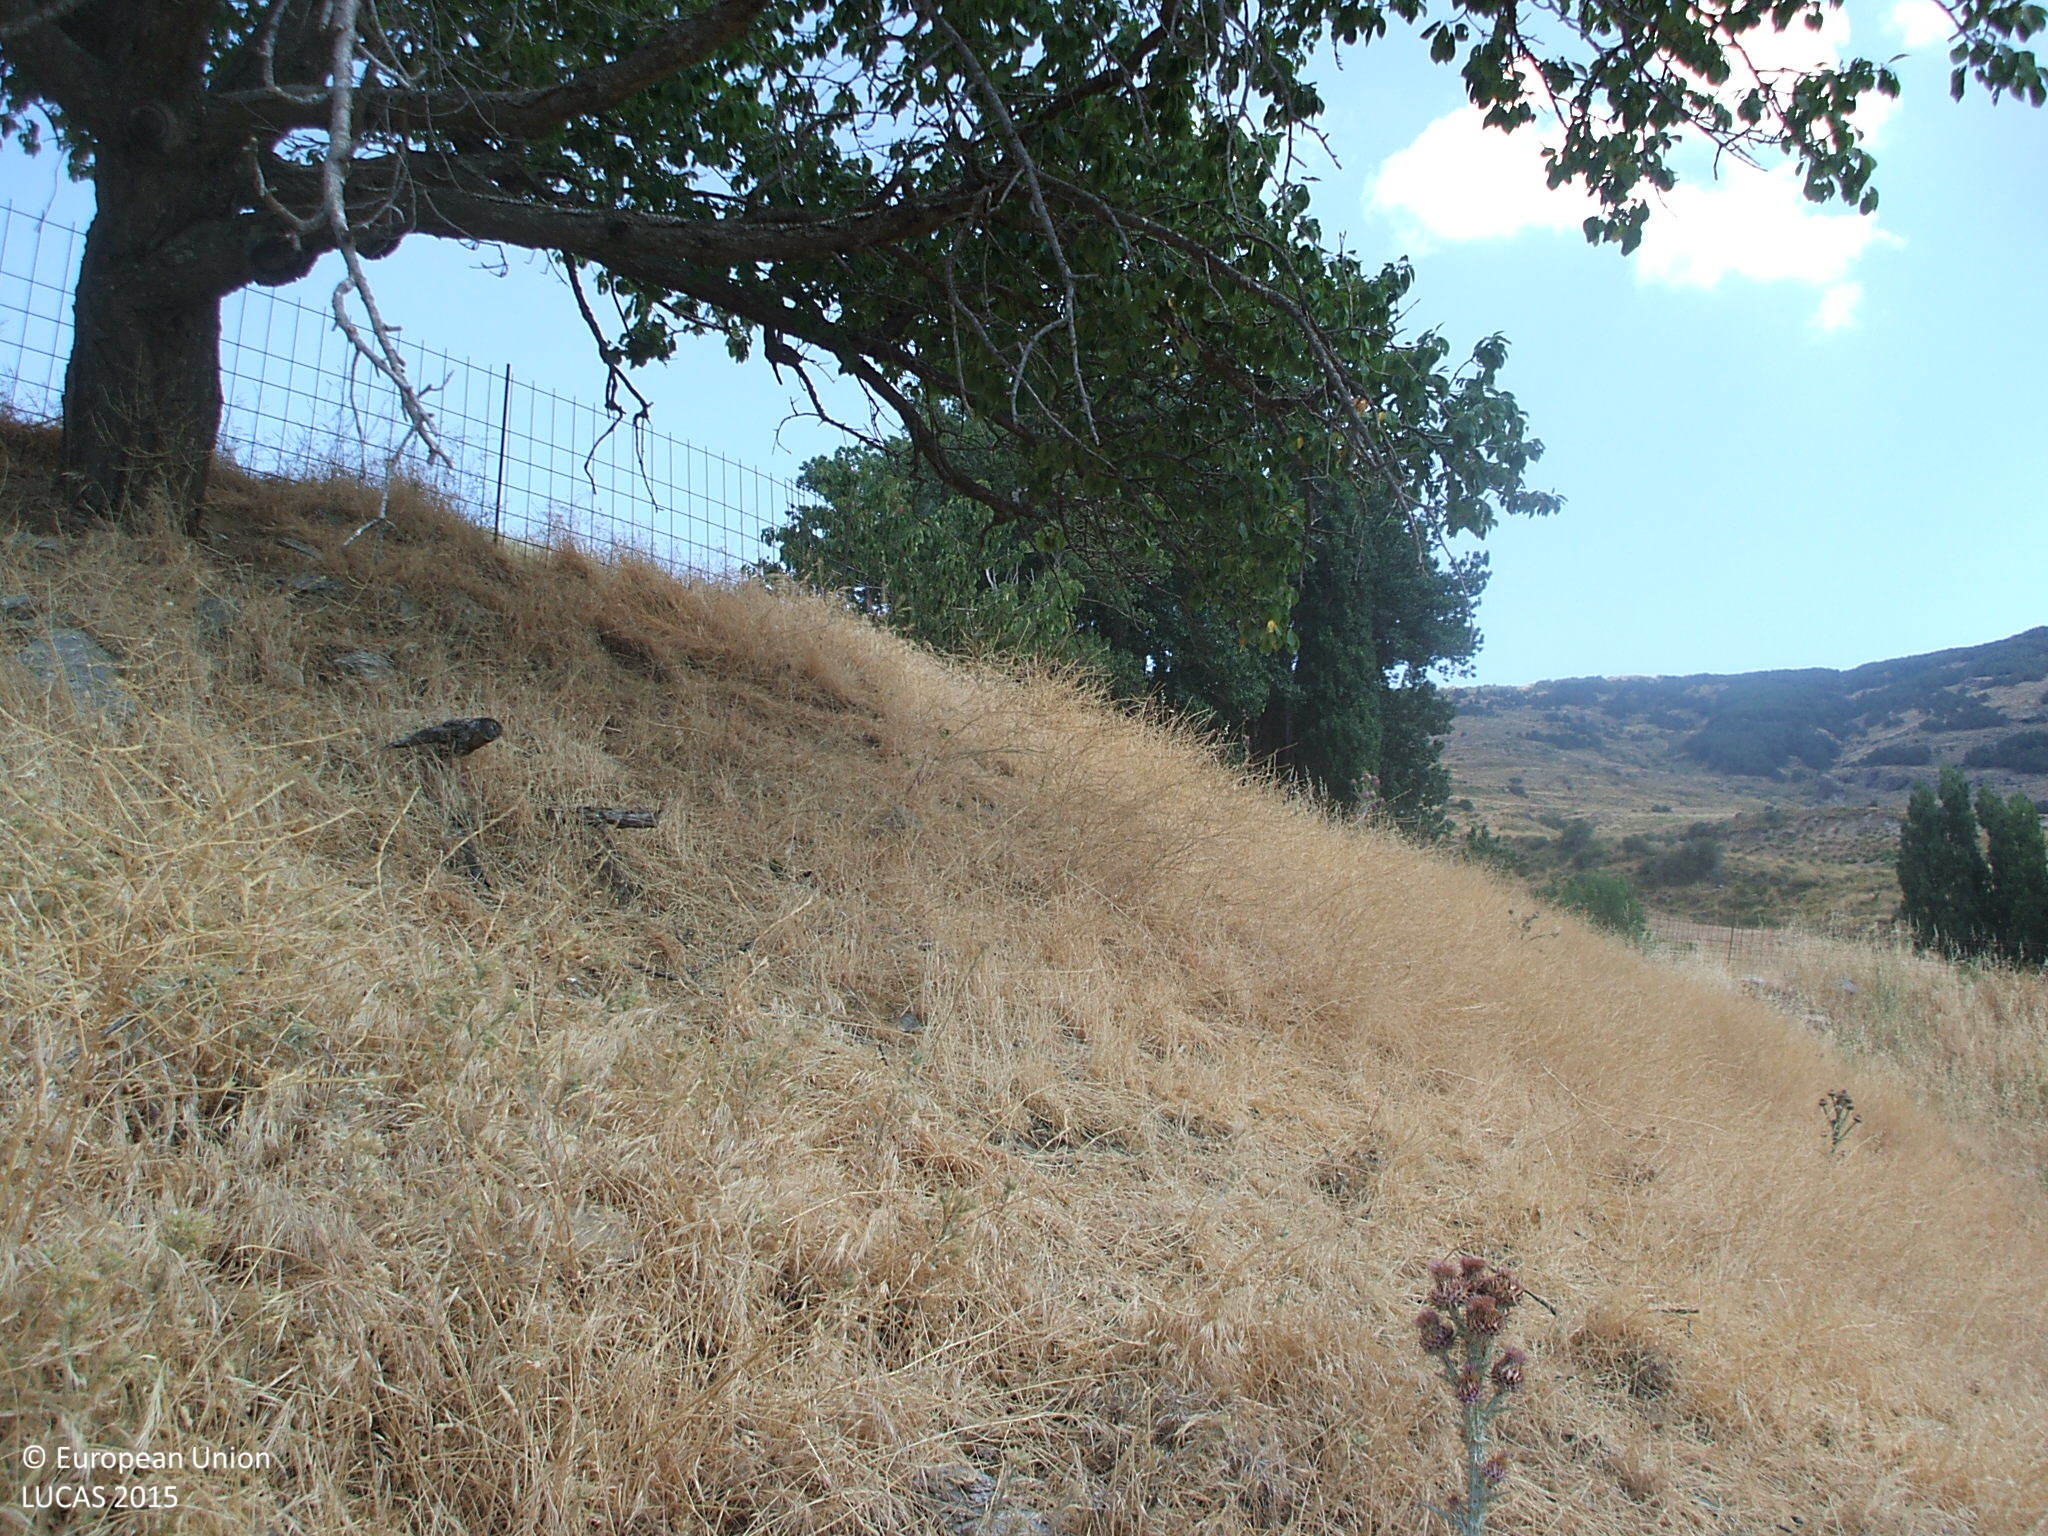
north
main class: Grassland
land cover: Grassland with sparse tree/shrub cover
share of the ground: > 75 %
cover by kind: herbaceous plants 95 %, broadleaved forest trees 5 %
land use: Semi-natural and natural areas not in use
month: July
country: ES
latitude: 37.0692
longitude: -2.8821
